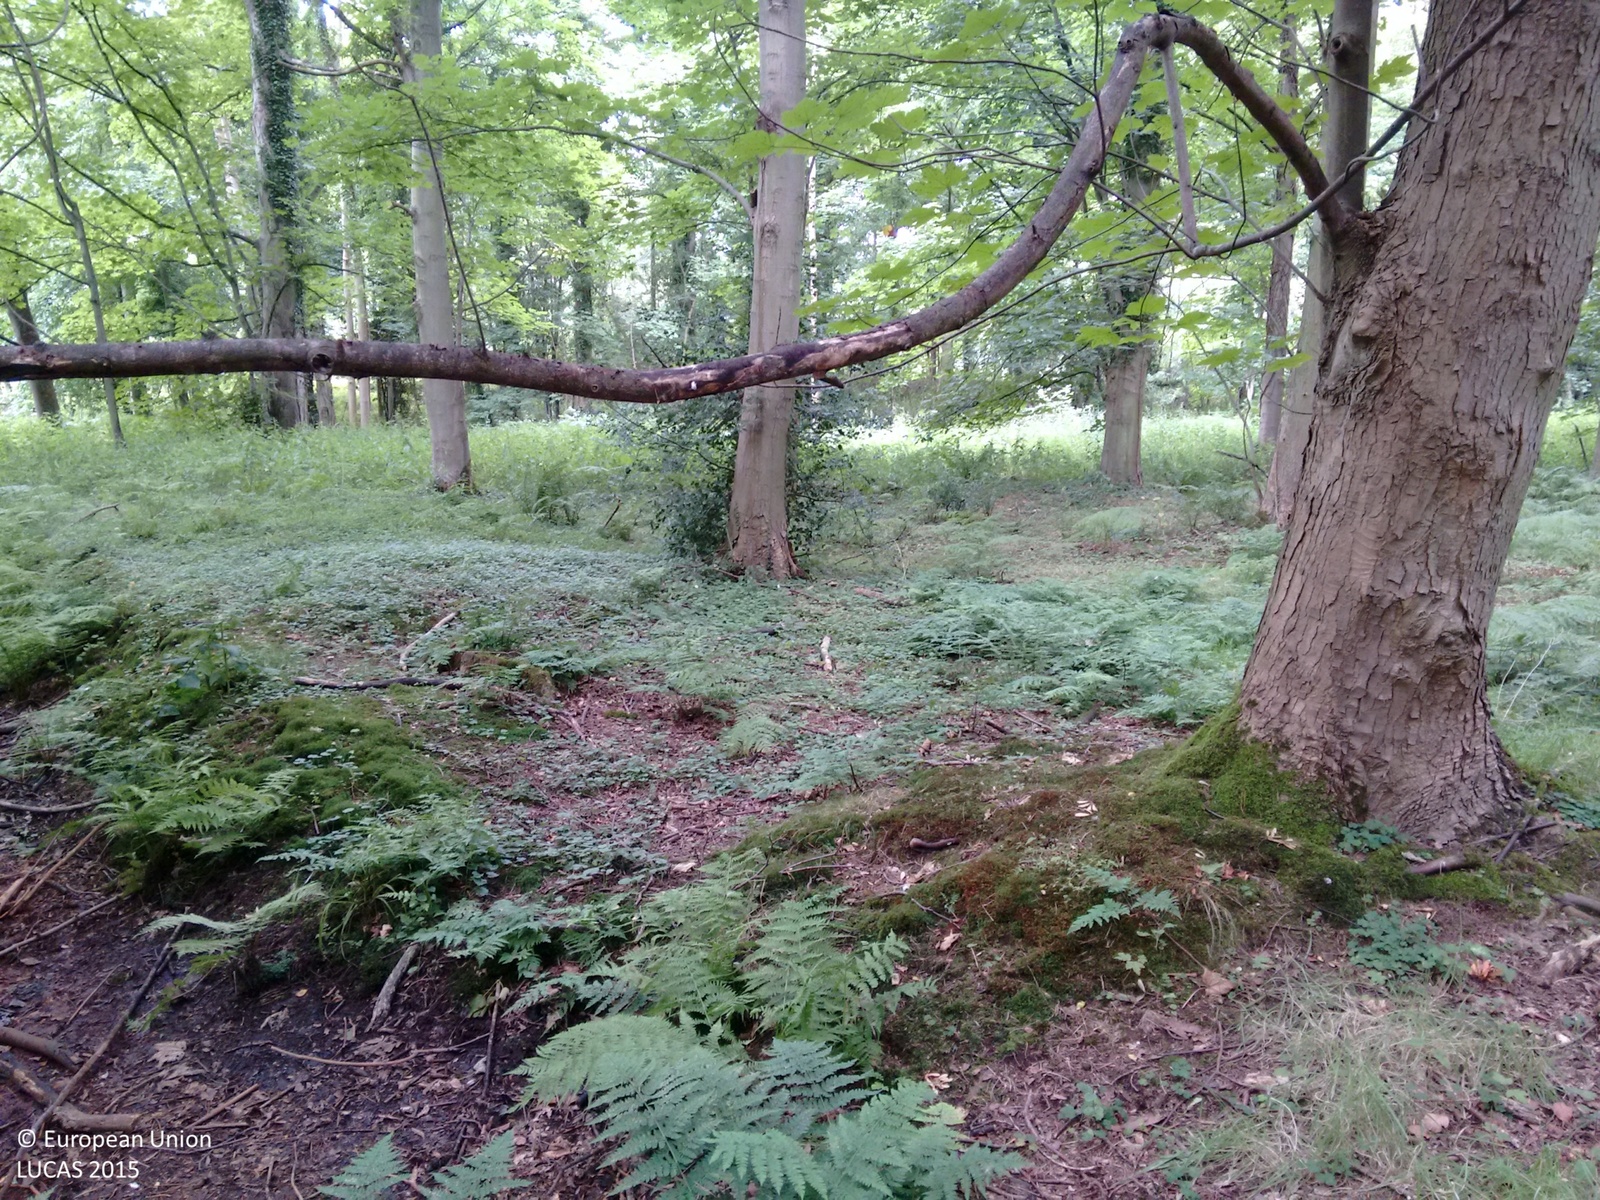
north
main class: Woodland
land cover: Broadleaved woodland
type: mesophytic deciduous forest
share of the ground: > 75 %
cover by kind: broadleaved forest trees 100 %
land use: Forestry
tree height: > 5 m
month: August
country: GB
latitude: 52.6403
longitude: 0.4104
